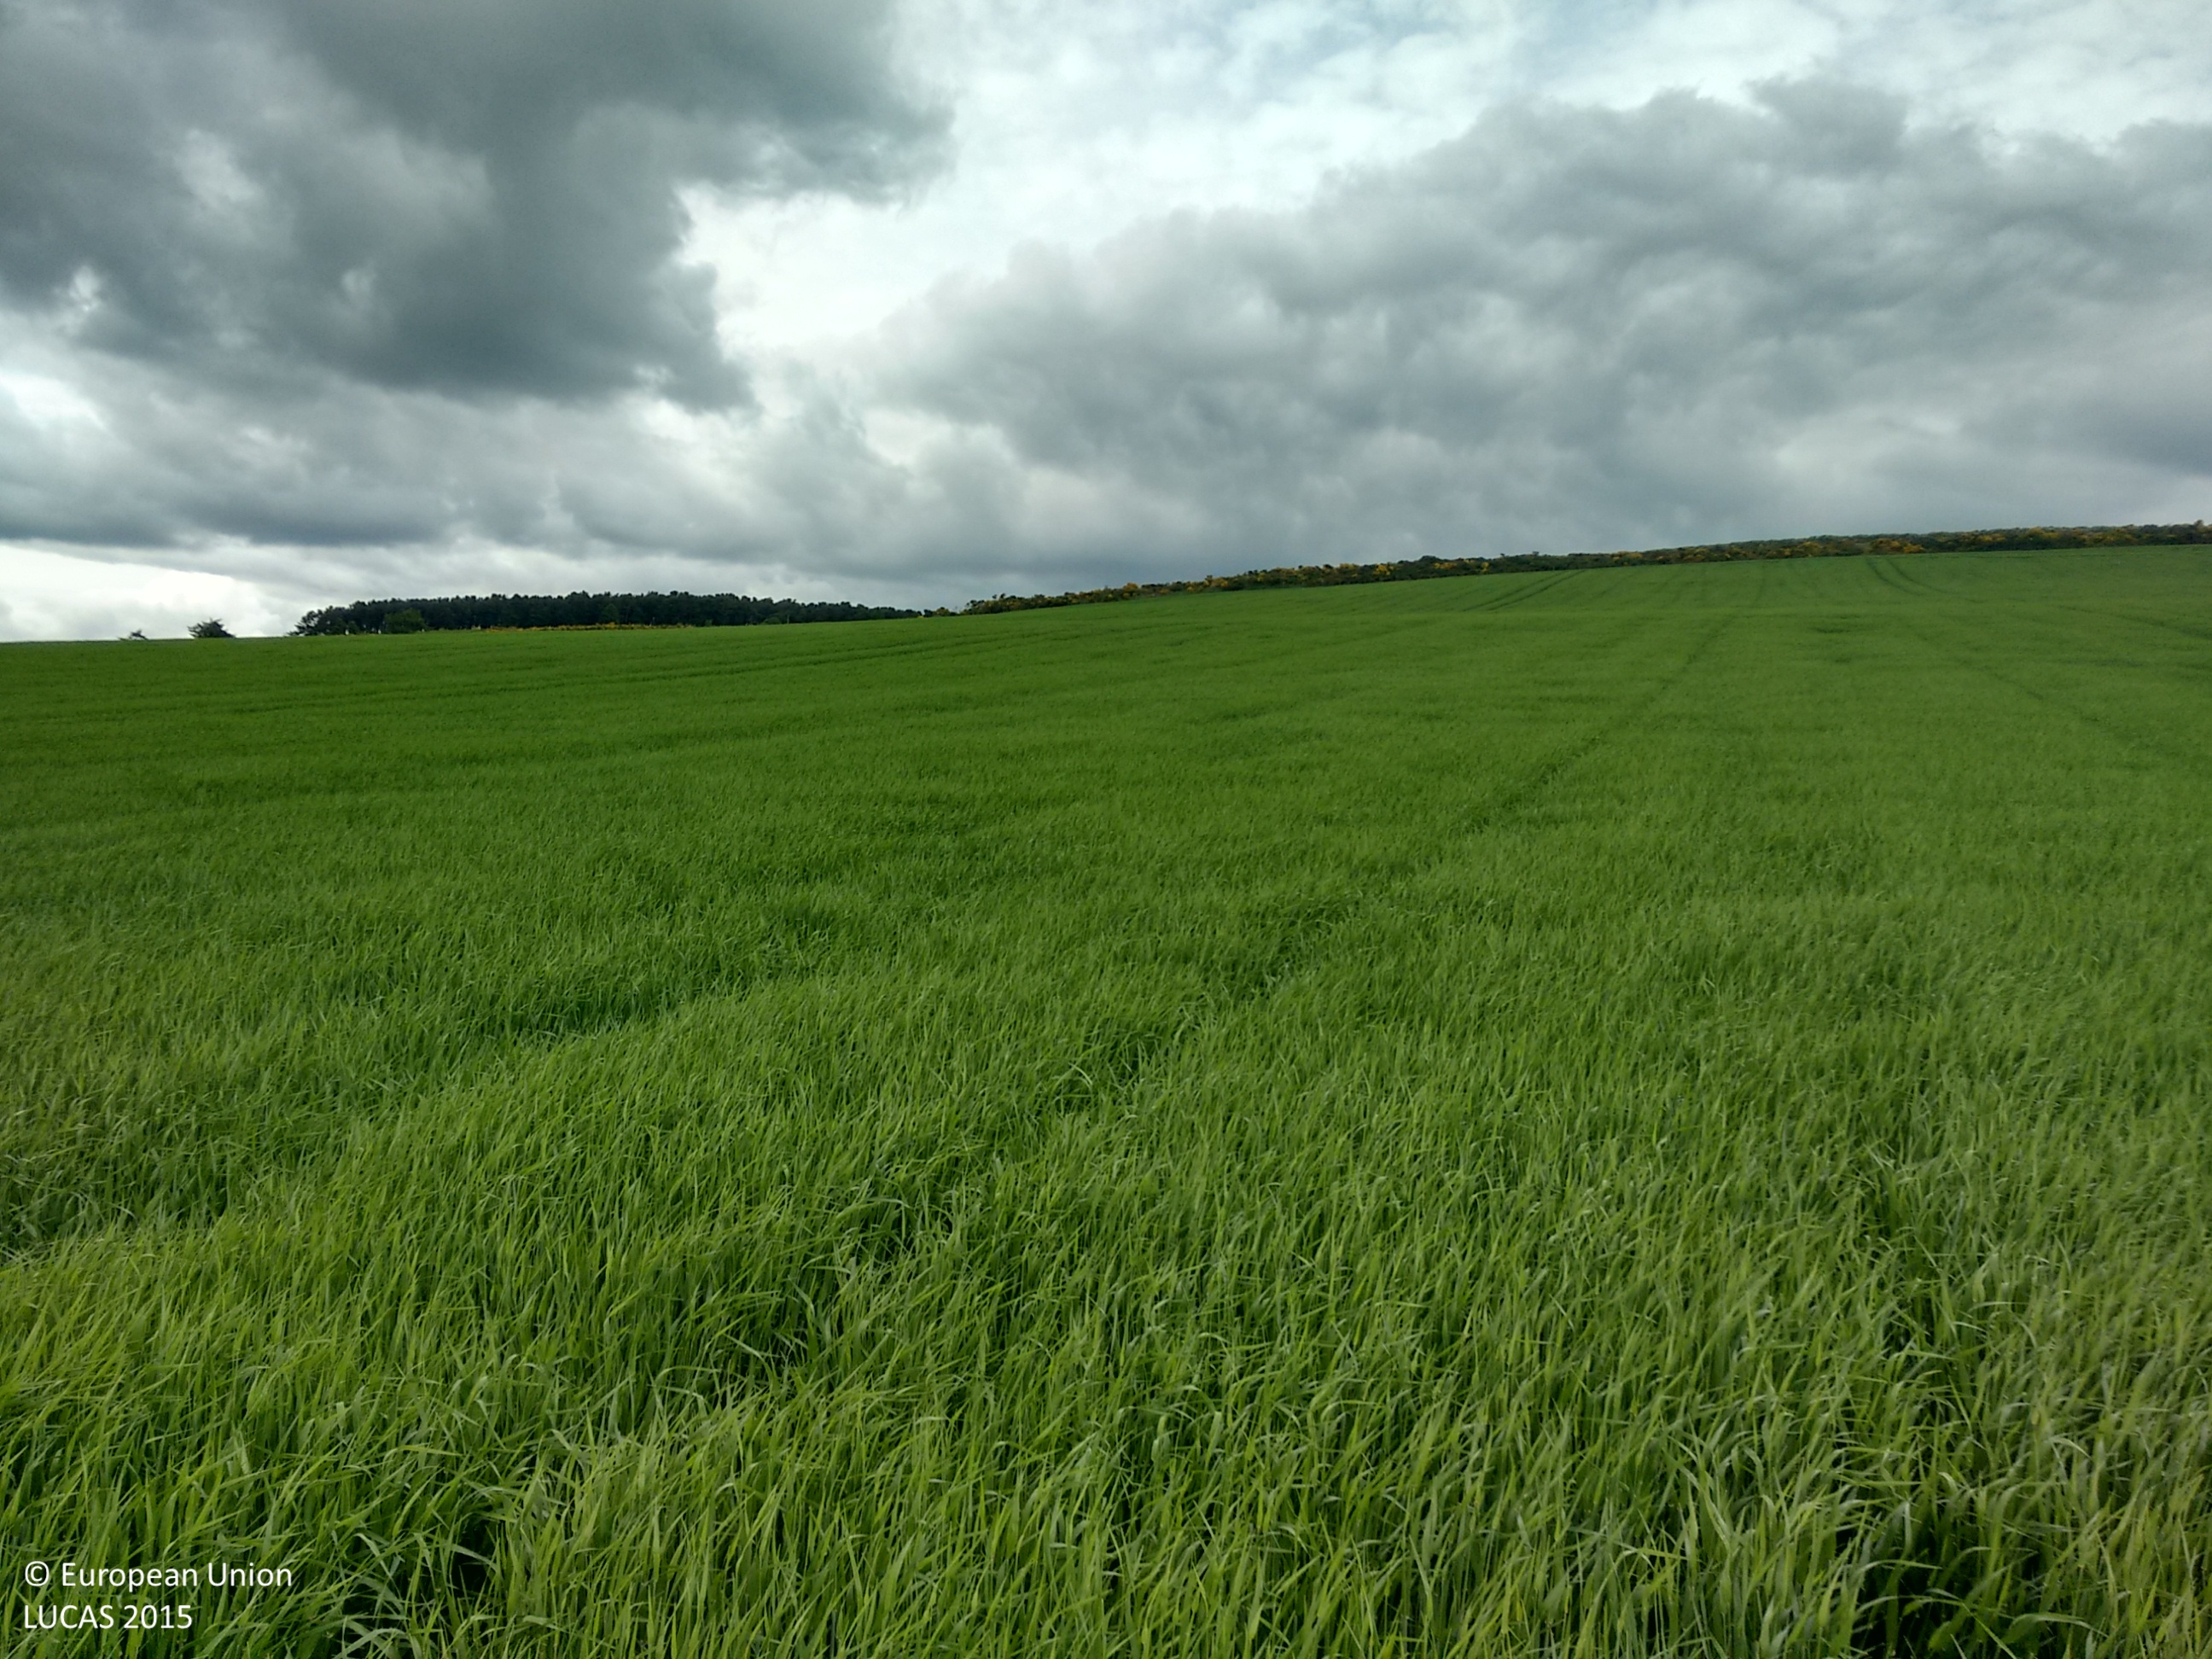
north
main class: Cropland
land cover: Barley
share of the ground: > 75 %
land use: Agriculture (excluding fallow land and kitchen gardens)
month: June
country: GB
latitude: 57.2103
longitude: -2.7233
